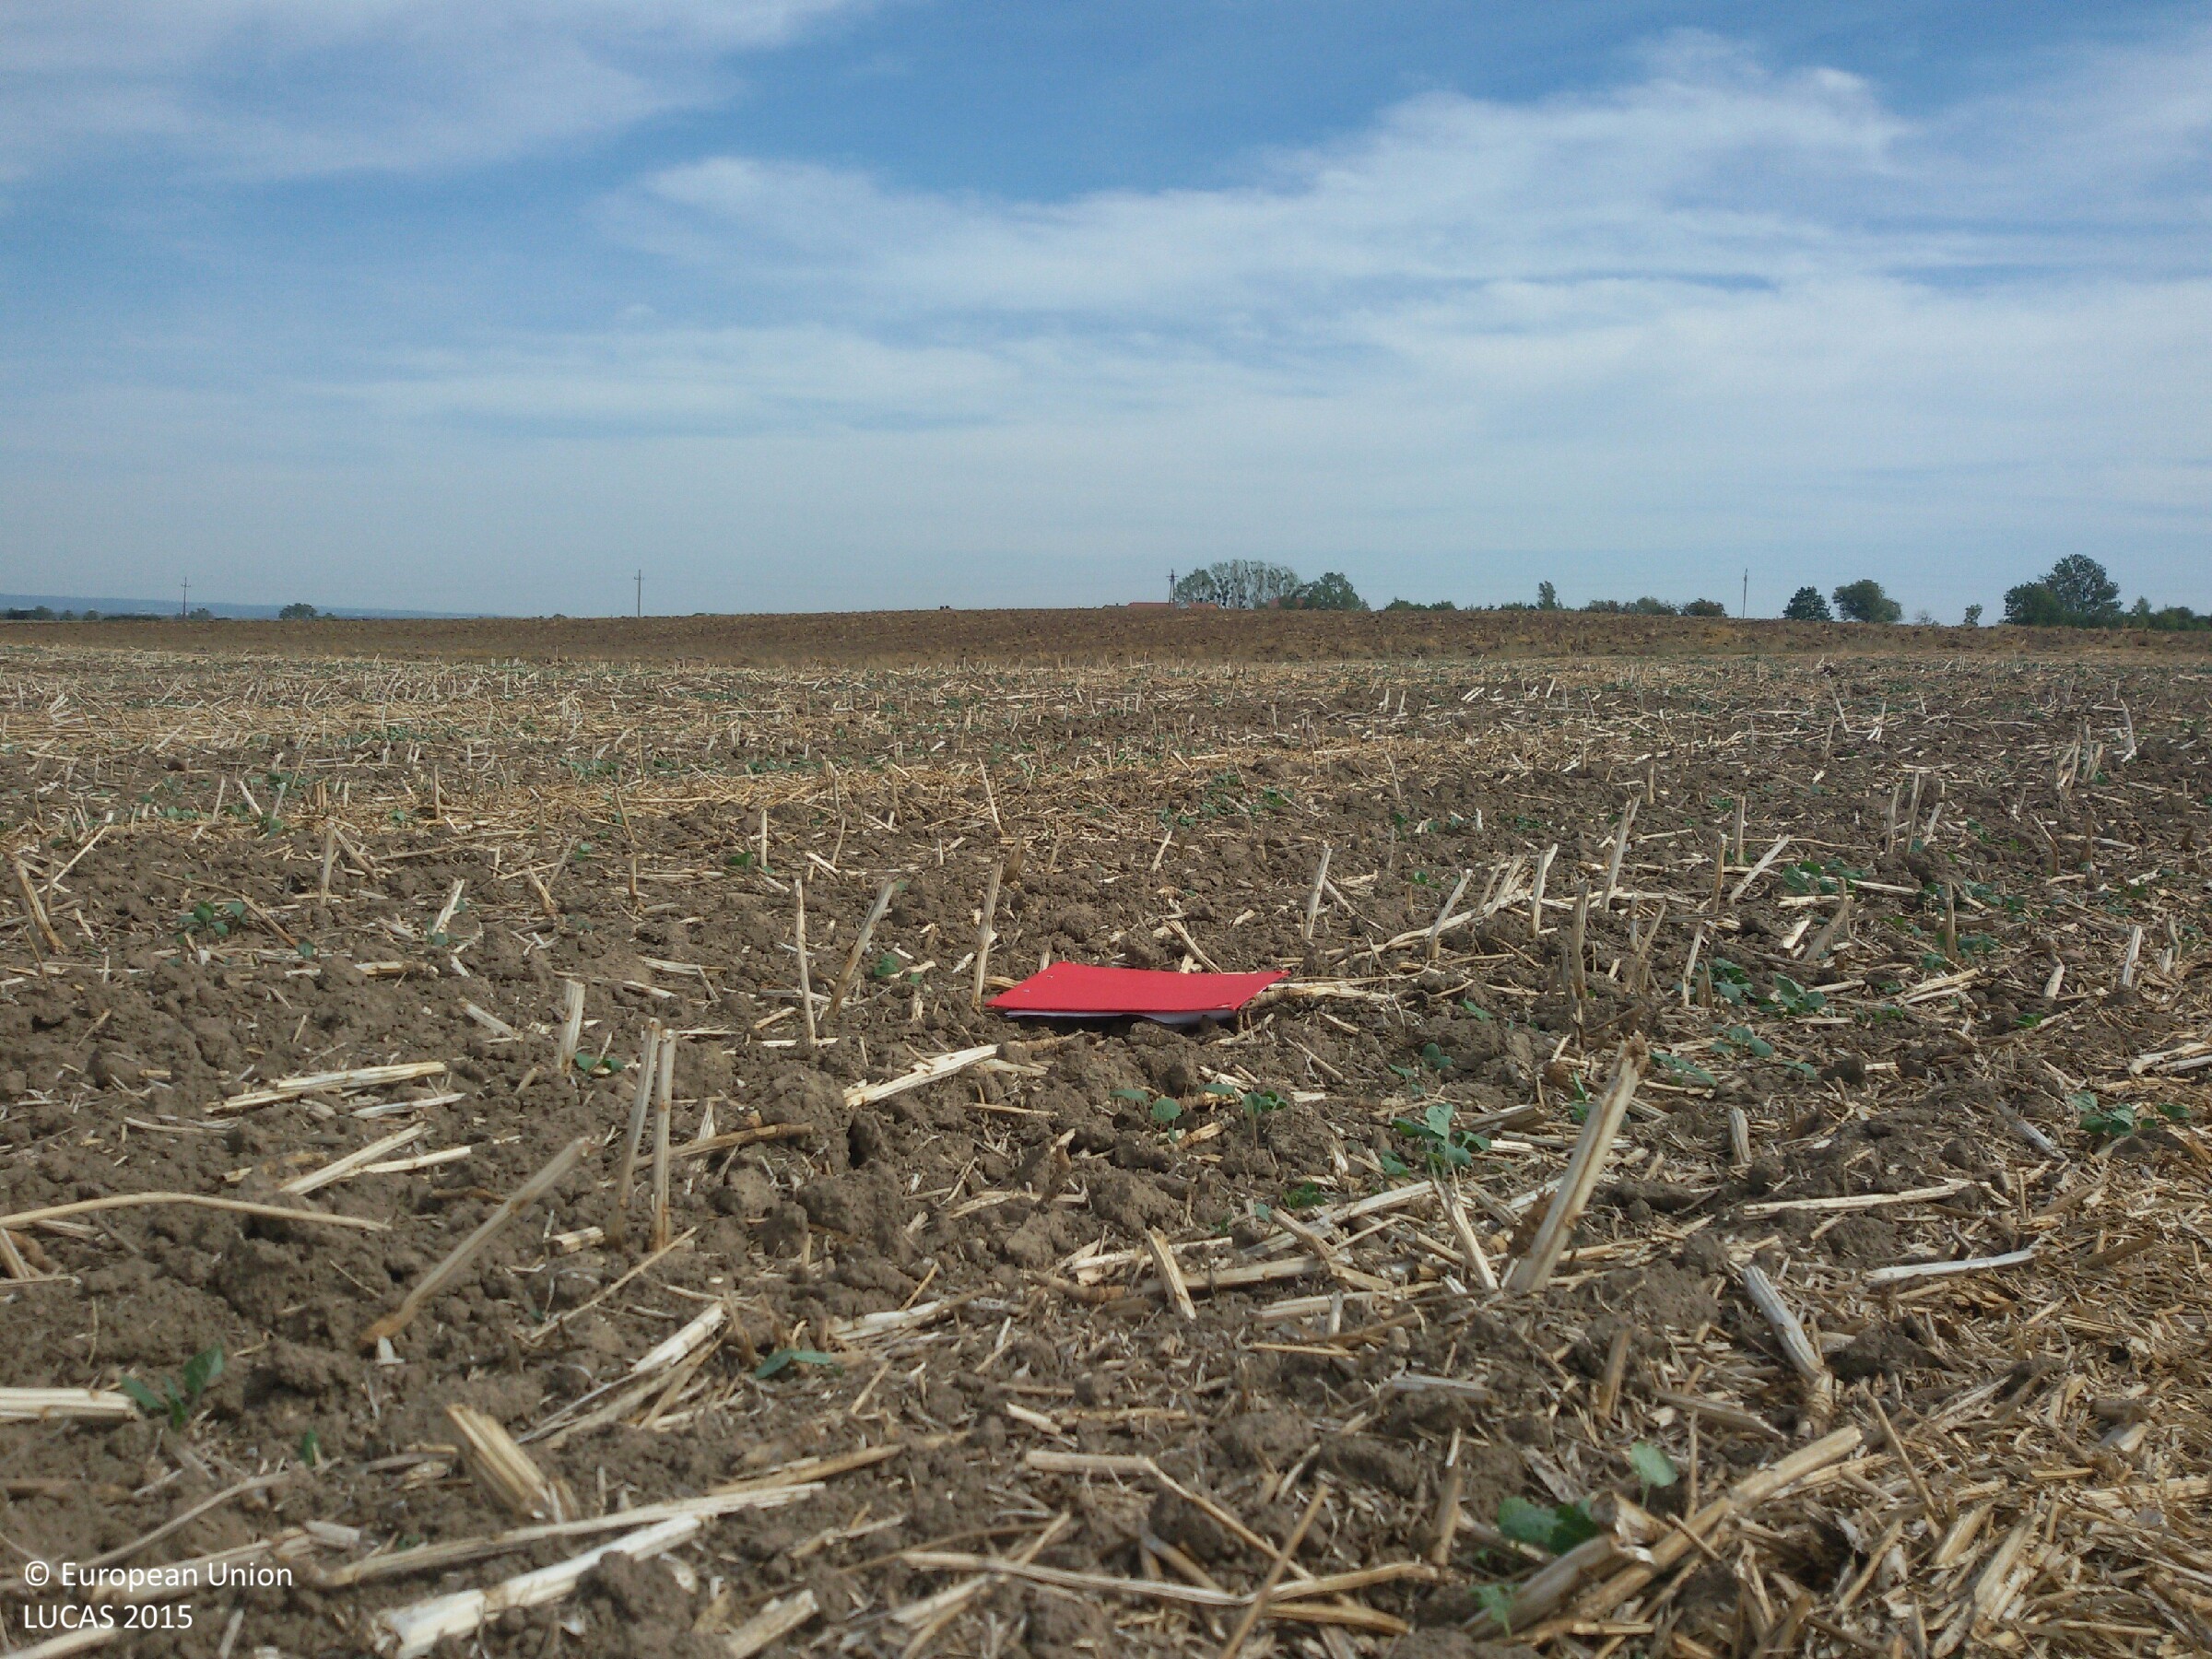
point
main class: Cropland
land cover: Rape and turnip rape
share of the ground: 25 - 50 %
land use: Agriculture (excluding fallow land and kitchen gardens)
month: August
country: PL
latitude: 53.9815
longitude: 19.3417
